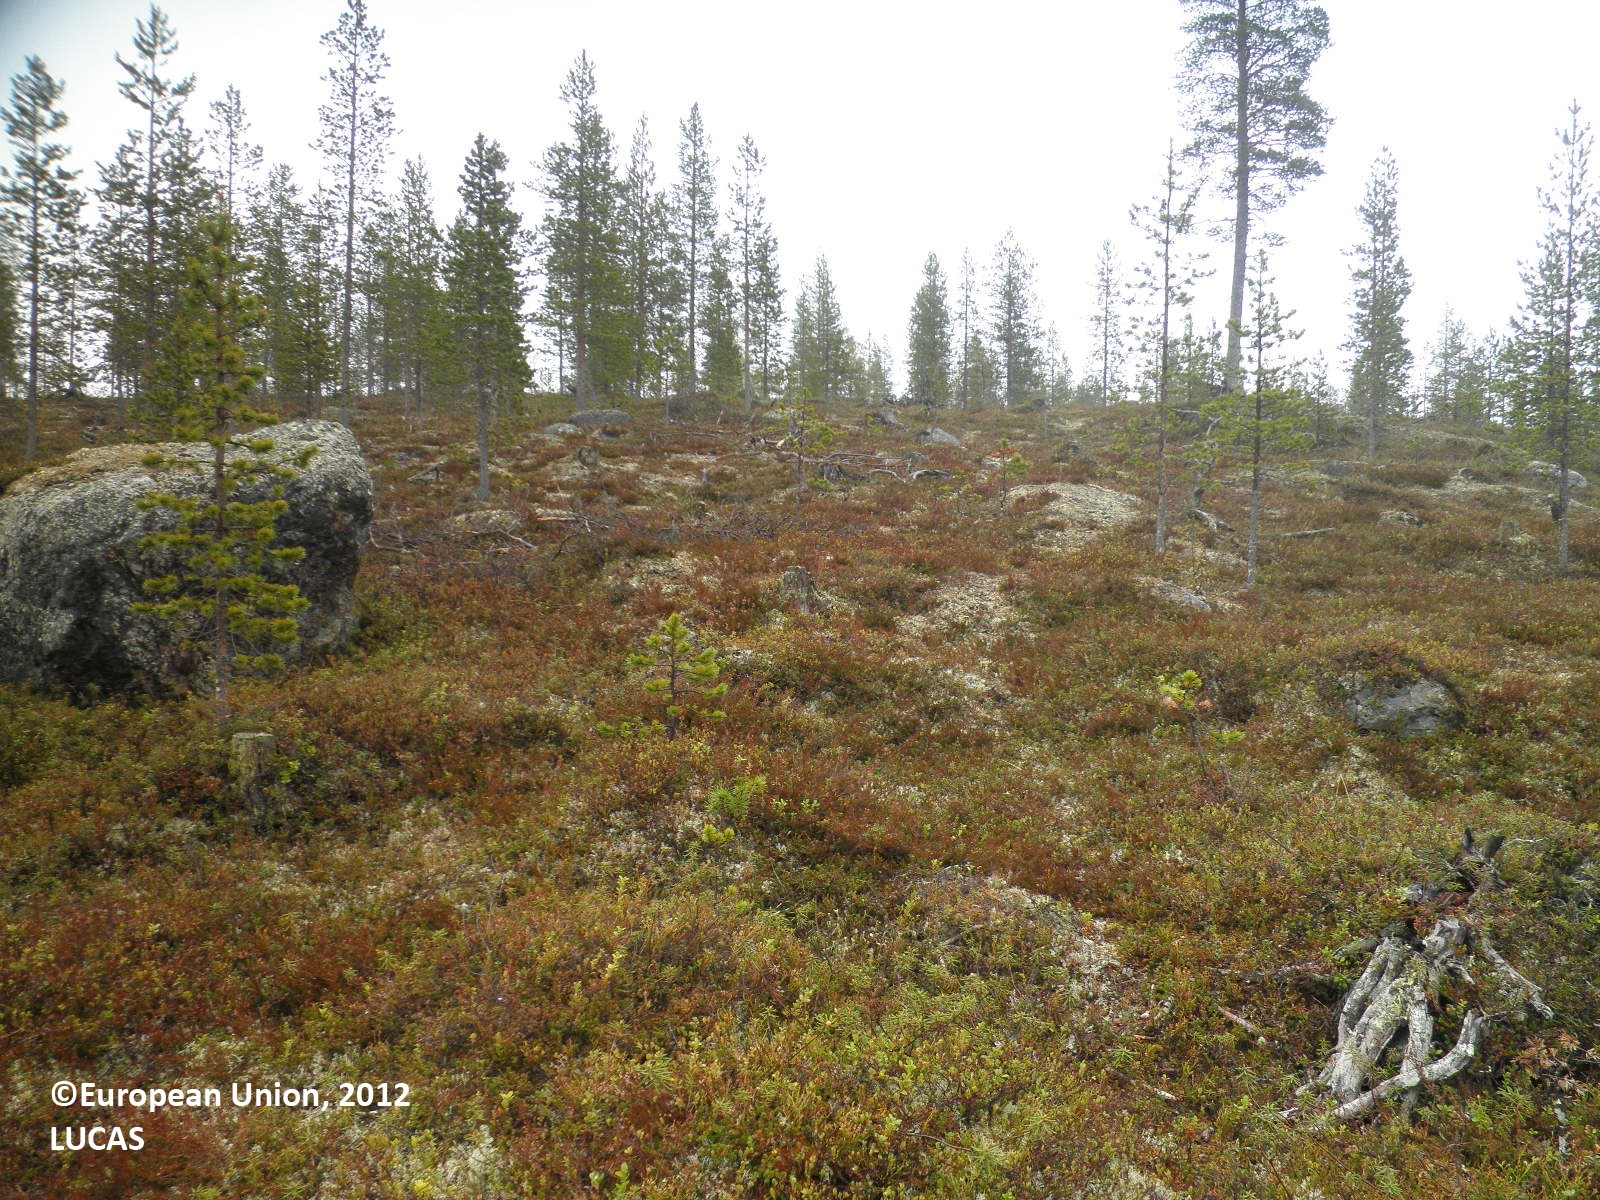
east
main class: Woodland
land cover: Pine dominated coniferous woodland
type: boreal forest
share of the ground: 10 - 25 %
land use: Forestry
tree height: > 5 m
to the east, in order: Pine dominated coniferous woodland
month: June
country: FI
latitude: 69.0809
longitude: 27.2018
